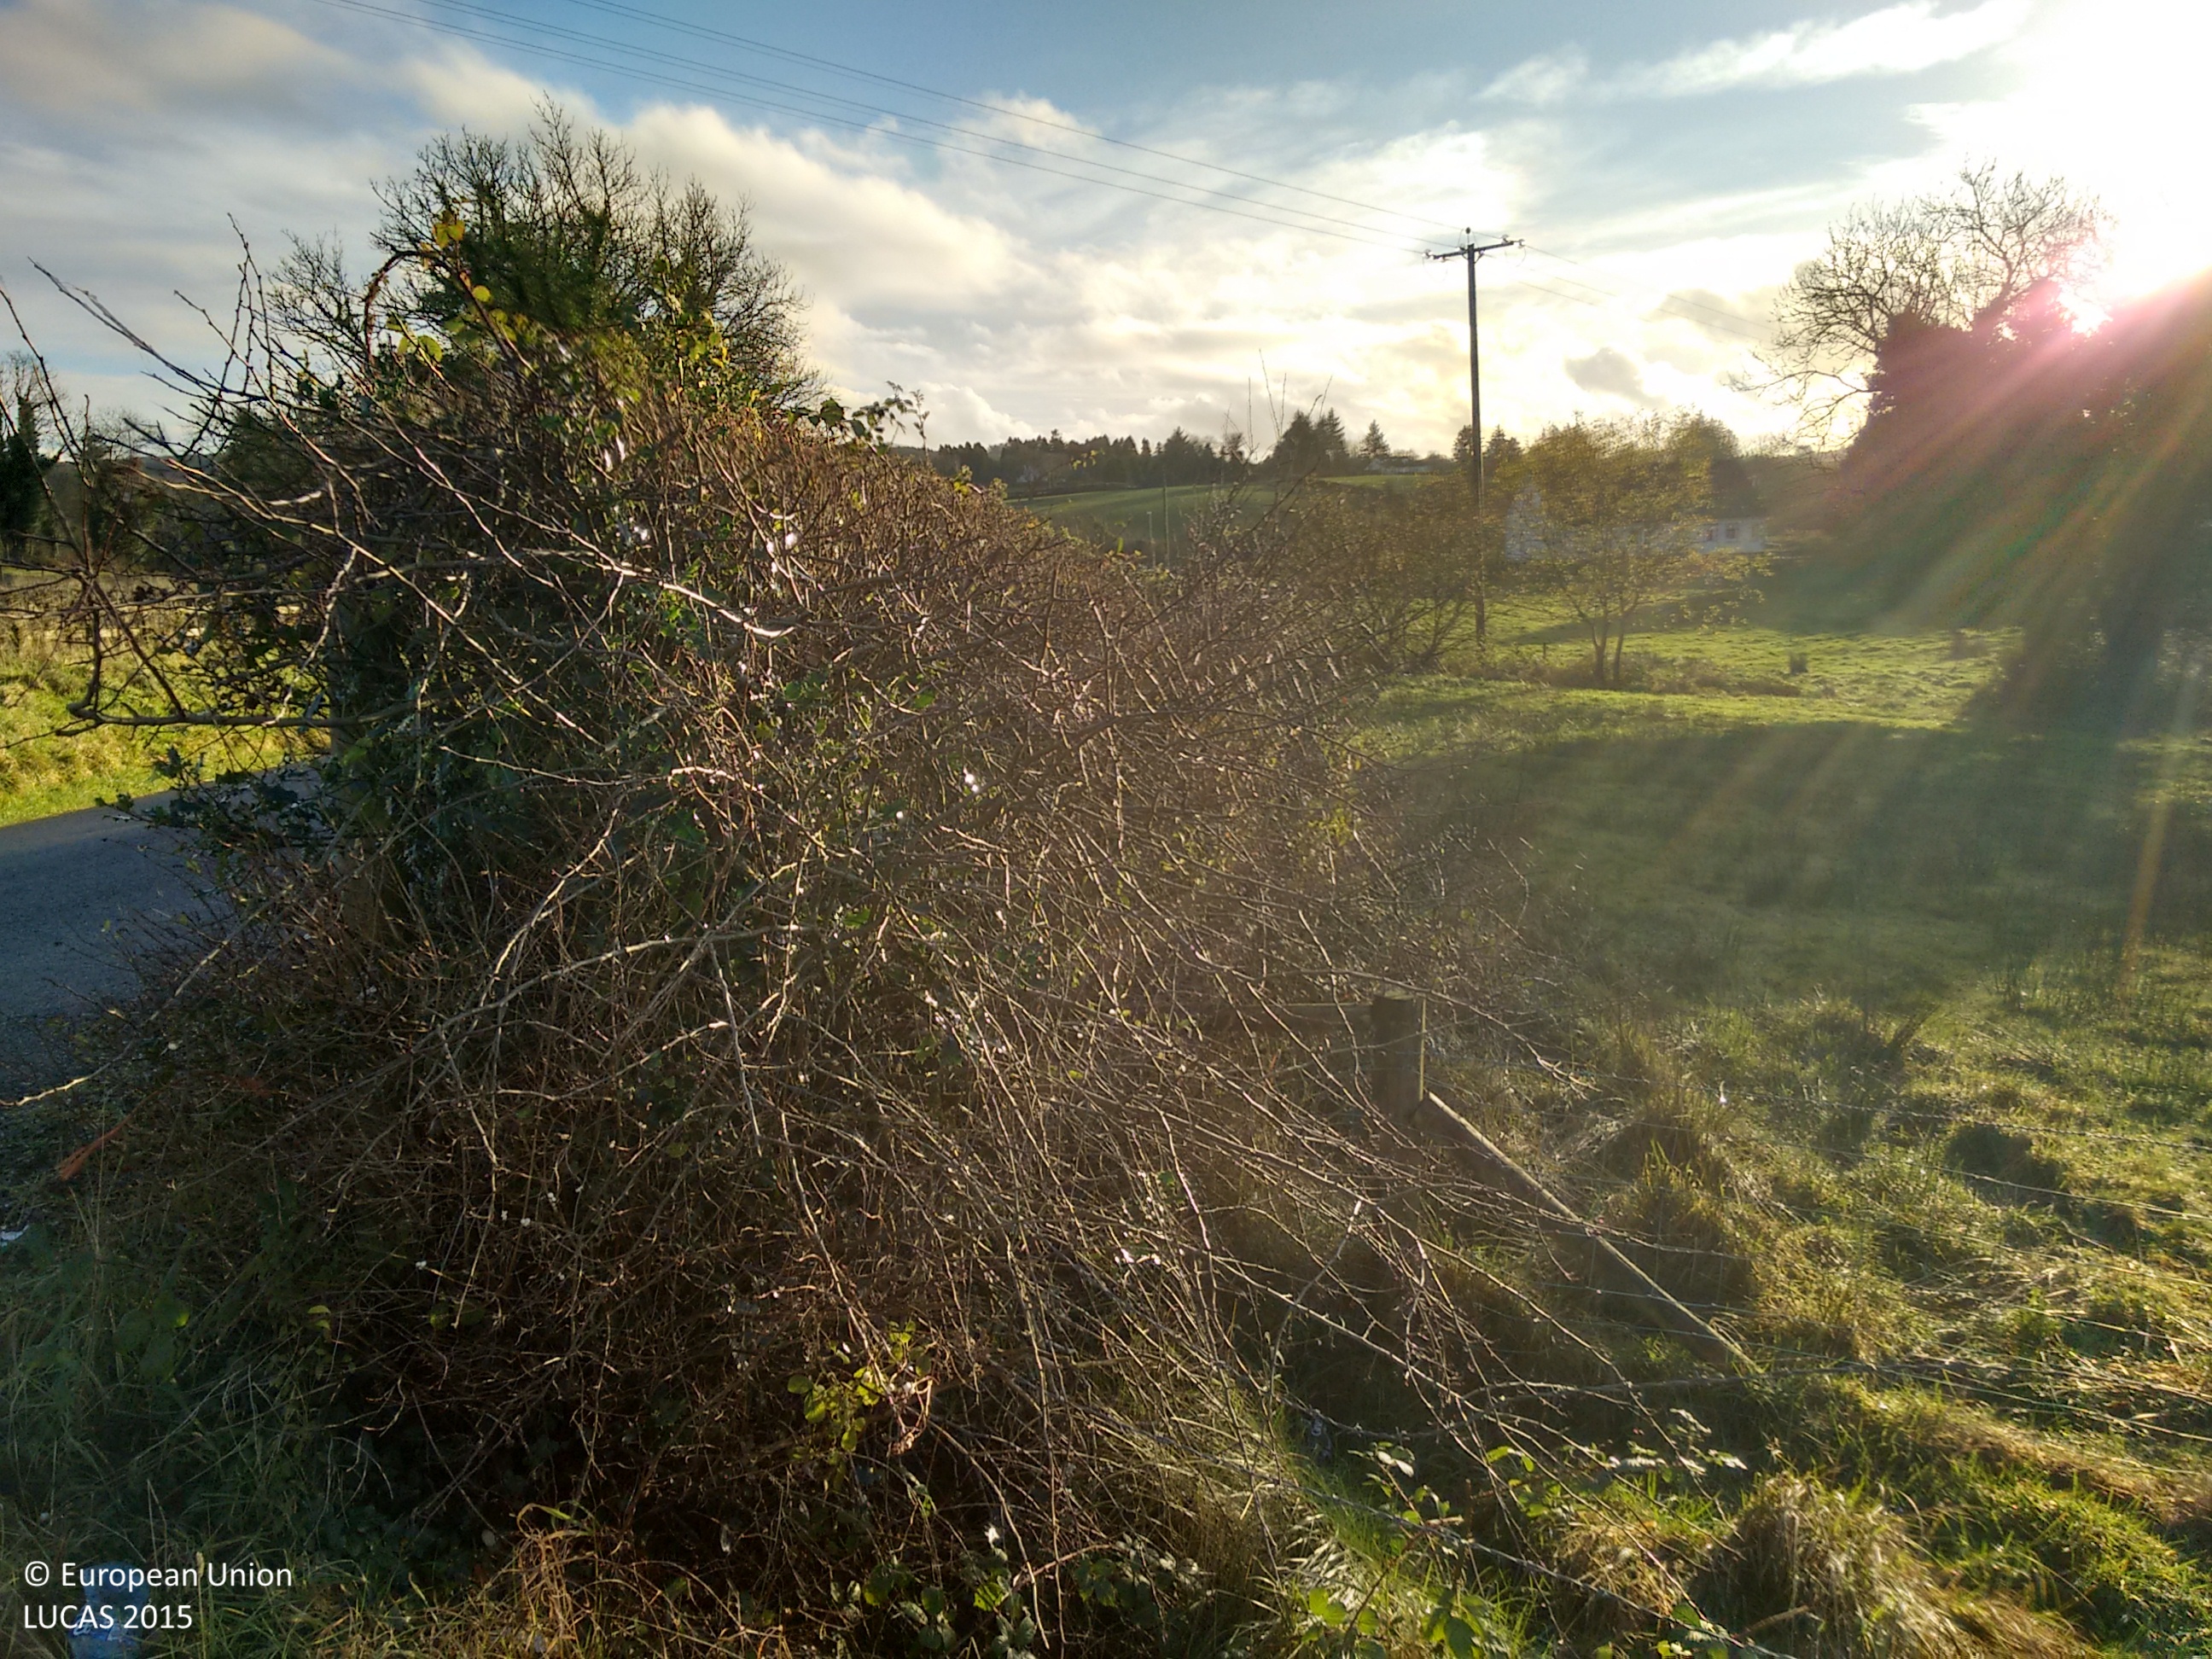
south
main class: Grassland
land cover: Grassland without tree/shrub cover
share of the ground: > 75 %
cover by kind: herbaceous plants 100 %
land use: Agriculture (excluding fallow land and kitchen gardens)
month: December
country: GB
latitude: 54.3353
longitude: -7.2978
